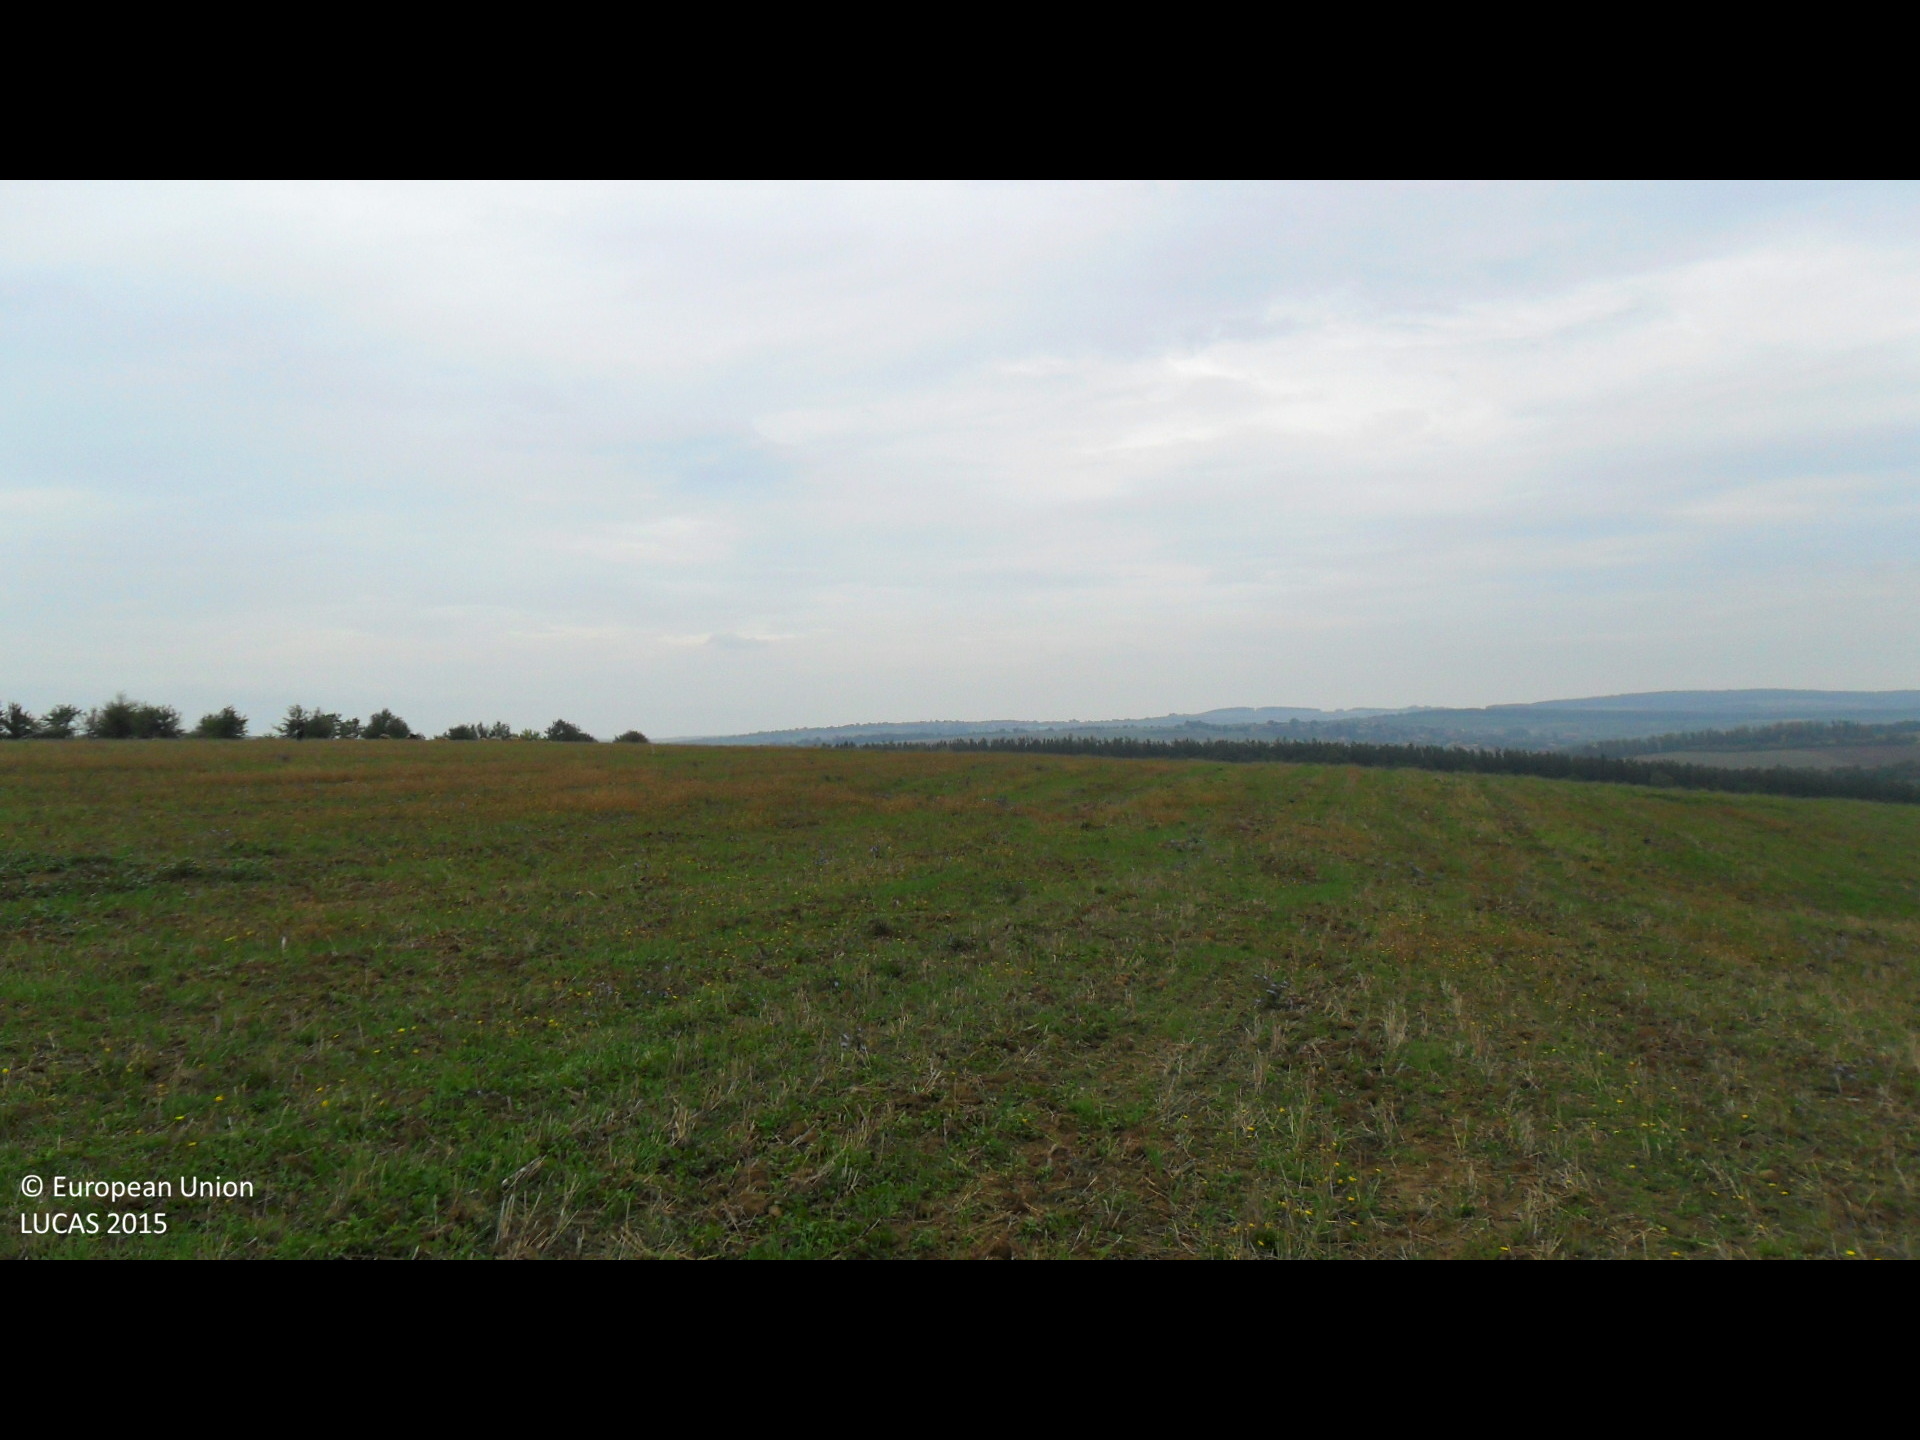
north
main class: Cropland
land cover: Common wheat
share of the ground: 10 - 25 %
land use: Agriculture (excluding fallow land and kitchen gardens)
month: September
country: BG
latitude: 43.0590
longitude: 26.3651
